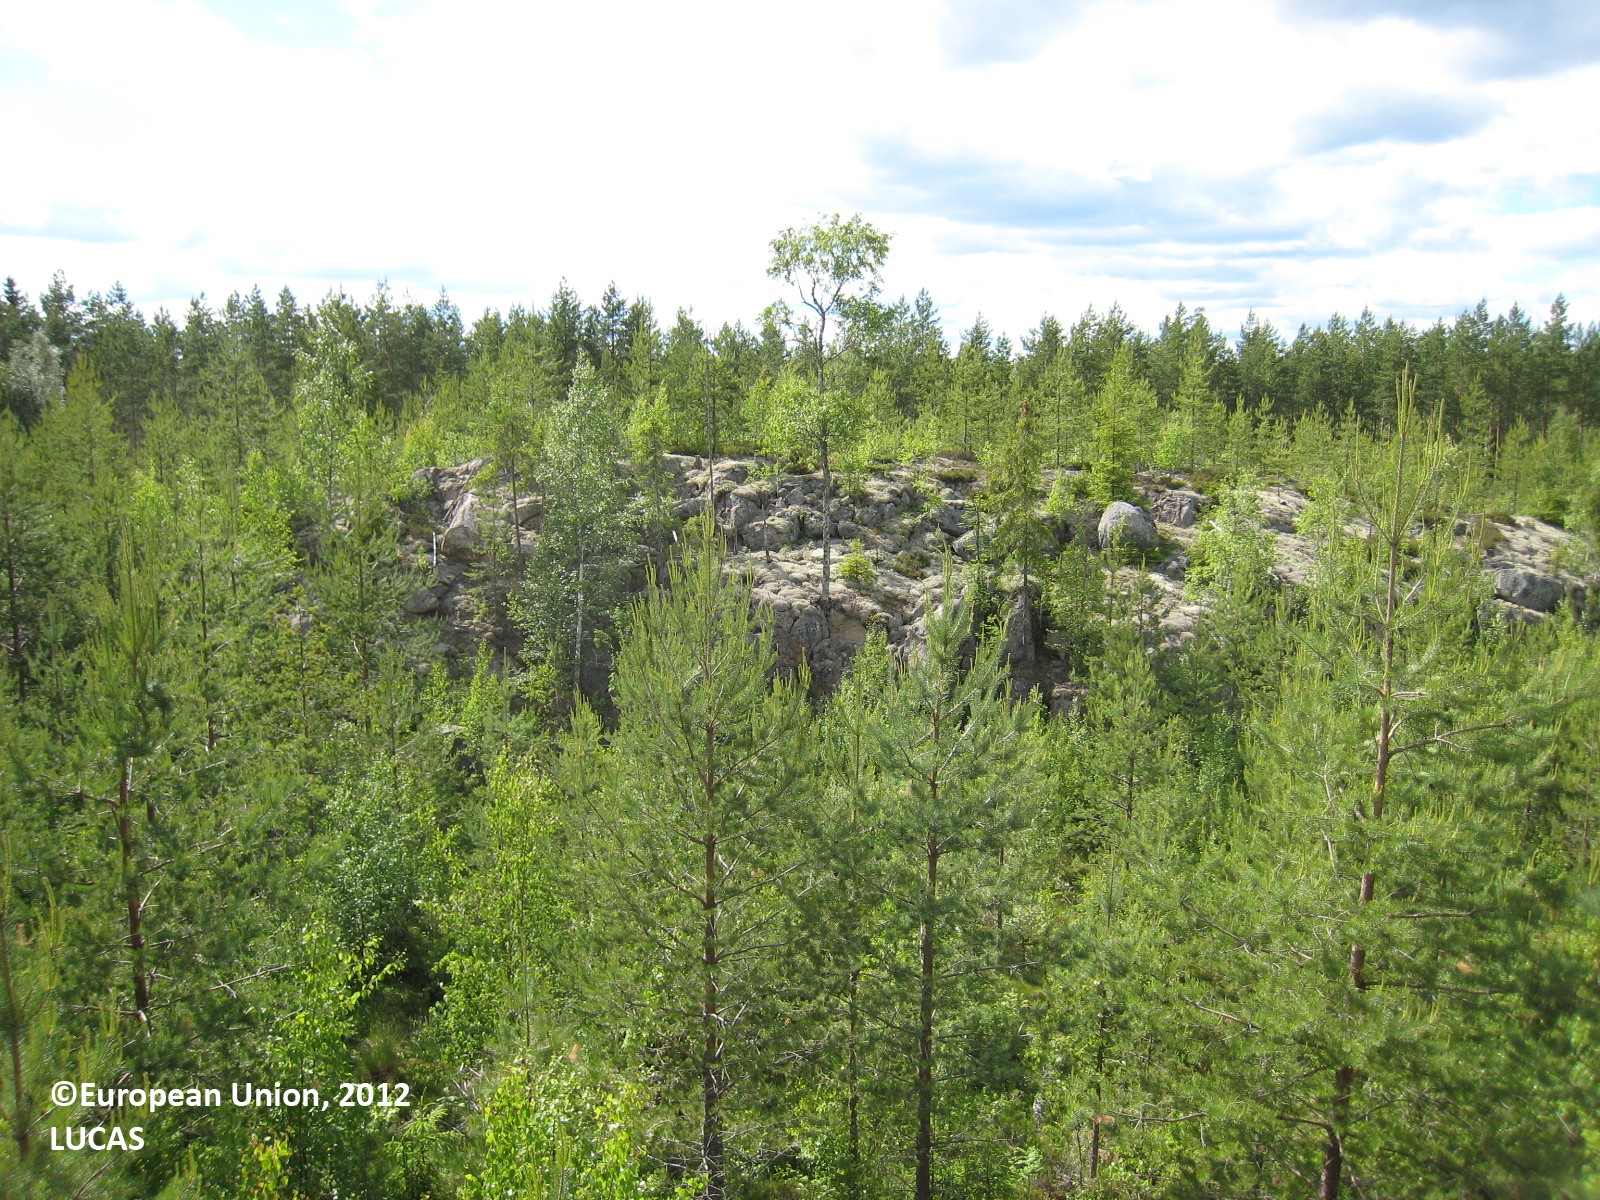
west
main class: Woodland
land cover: Pine dominated mixed woodland
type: boreal forest
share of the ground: 50 - 75 %
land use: Forestry
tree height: > 5 m
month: June
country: FI
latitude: 62.1691
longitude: 26.2035
